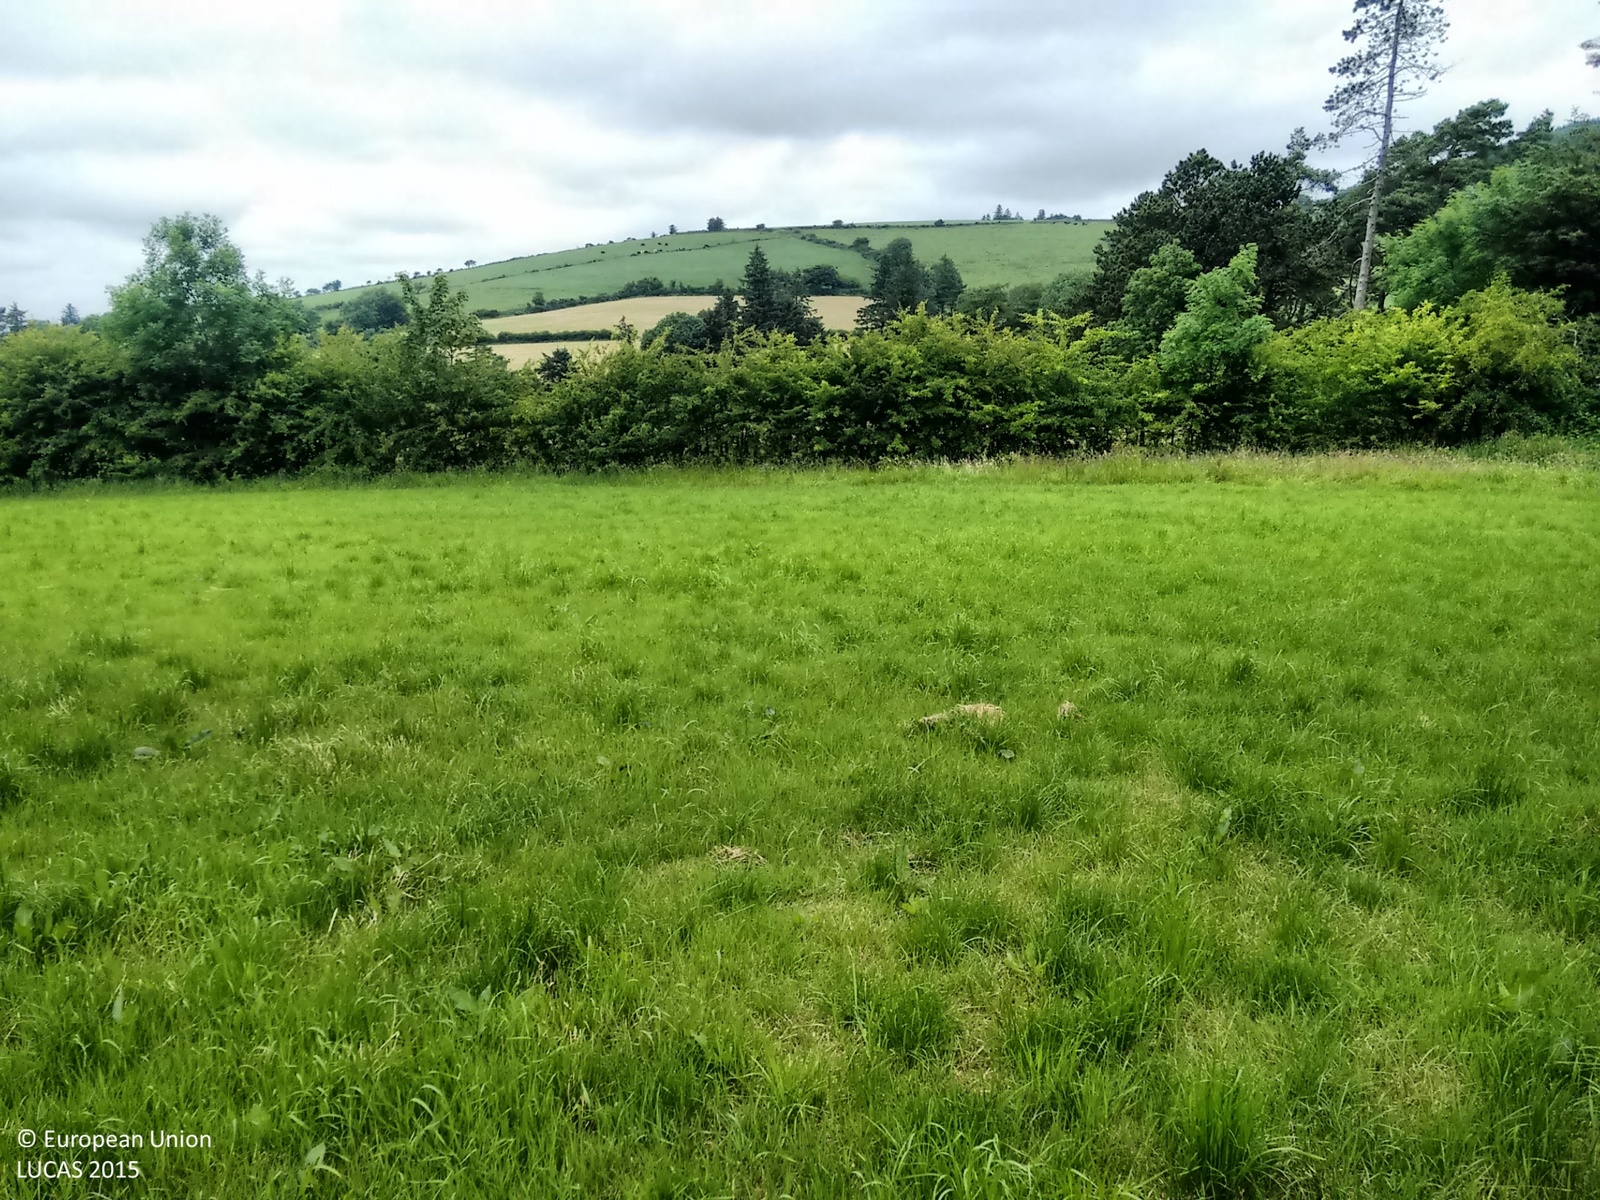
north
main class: Grassland
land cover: Grassland without tree/shrub cover
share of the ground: > 75 %
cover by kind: herbaceous plants 100 %
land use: Agriculture (excluding fallow land and kitchen gardens)
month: July
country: IE
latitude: 52.3328
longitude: -8.4632
